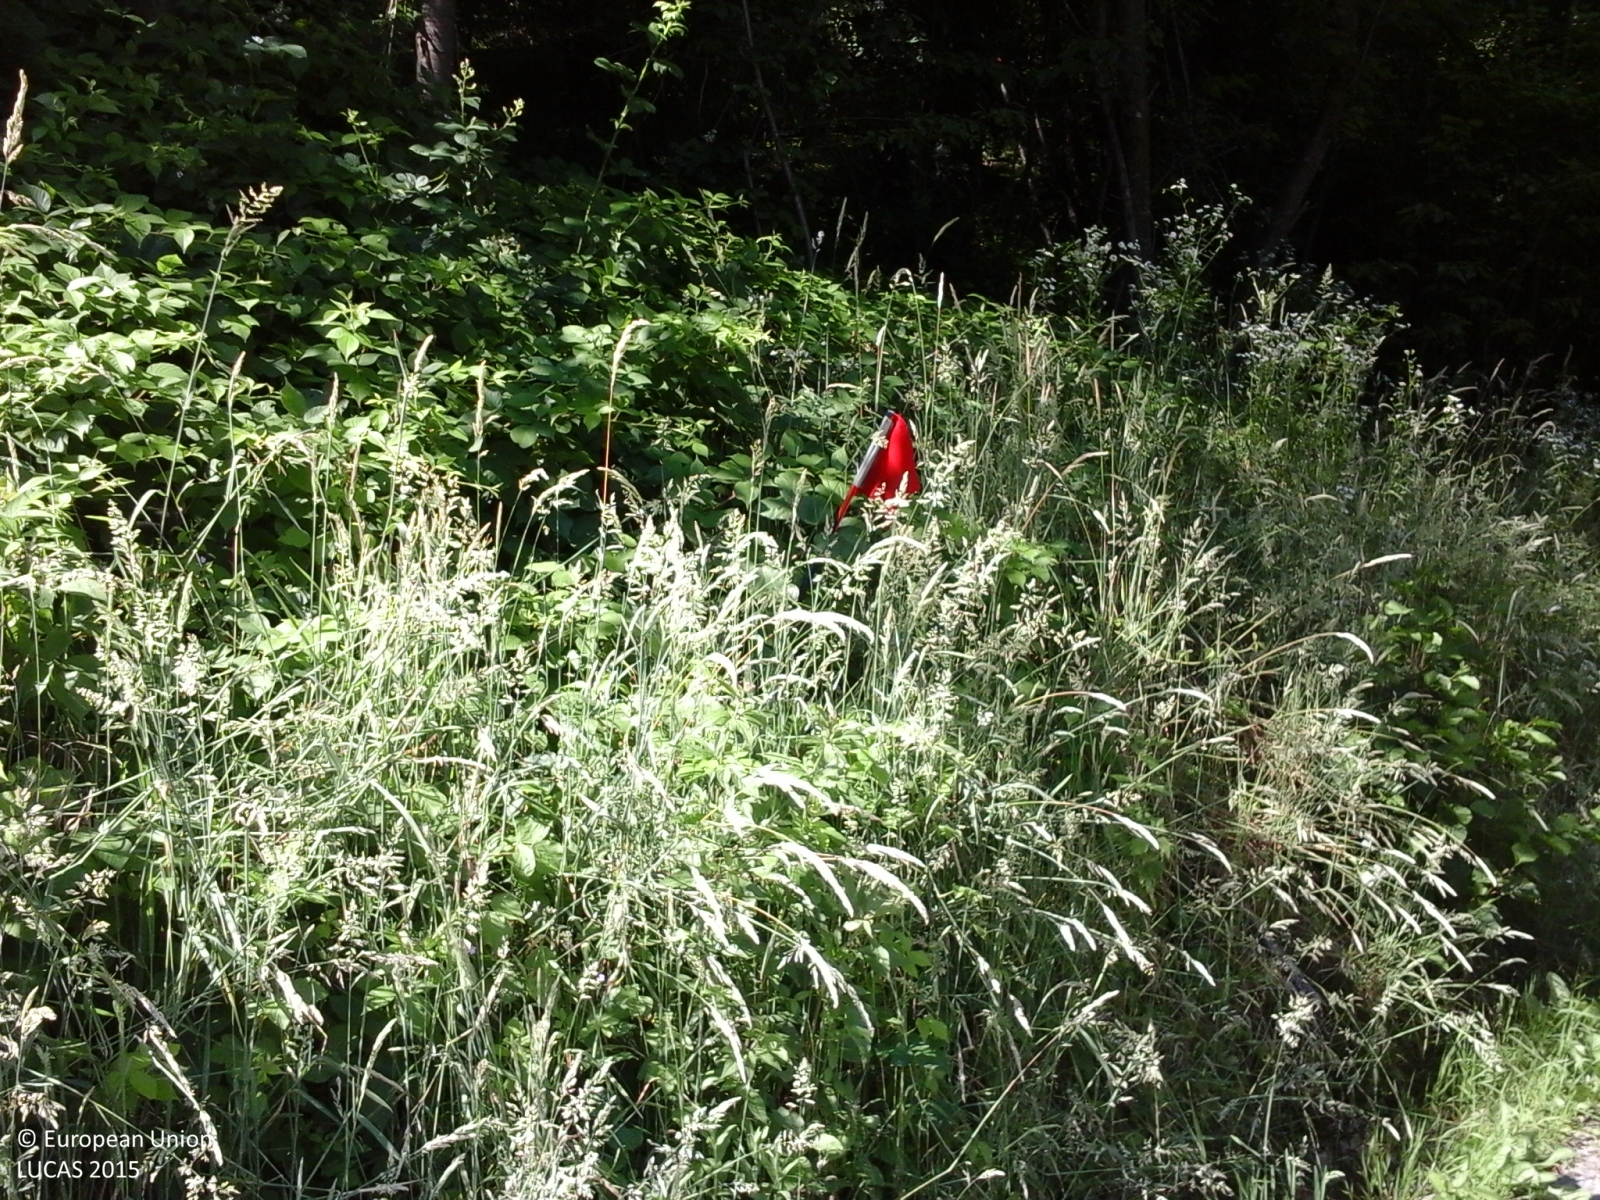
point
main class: Woodland
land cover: Broadleaved woodland
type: thermophilous deciduous forest
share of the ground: > 75 %
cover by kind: broadleaved forest trees 40 %, shrubs 40 %, herbaceous plants 20 %
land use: Forestry
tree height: > 5 m
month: June
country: IT
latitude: 44.3100
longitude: 7.8360
